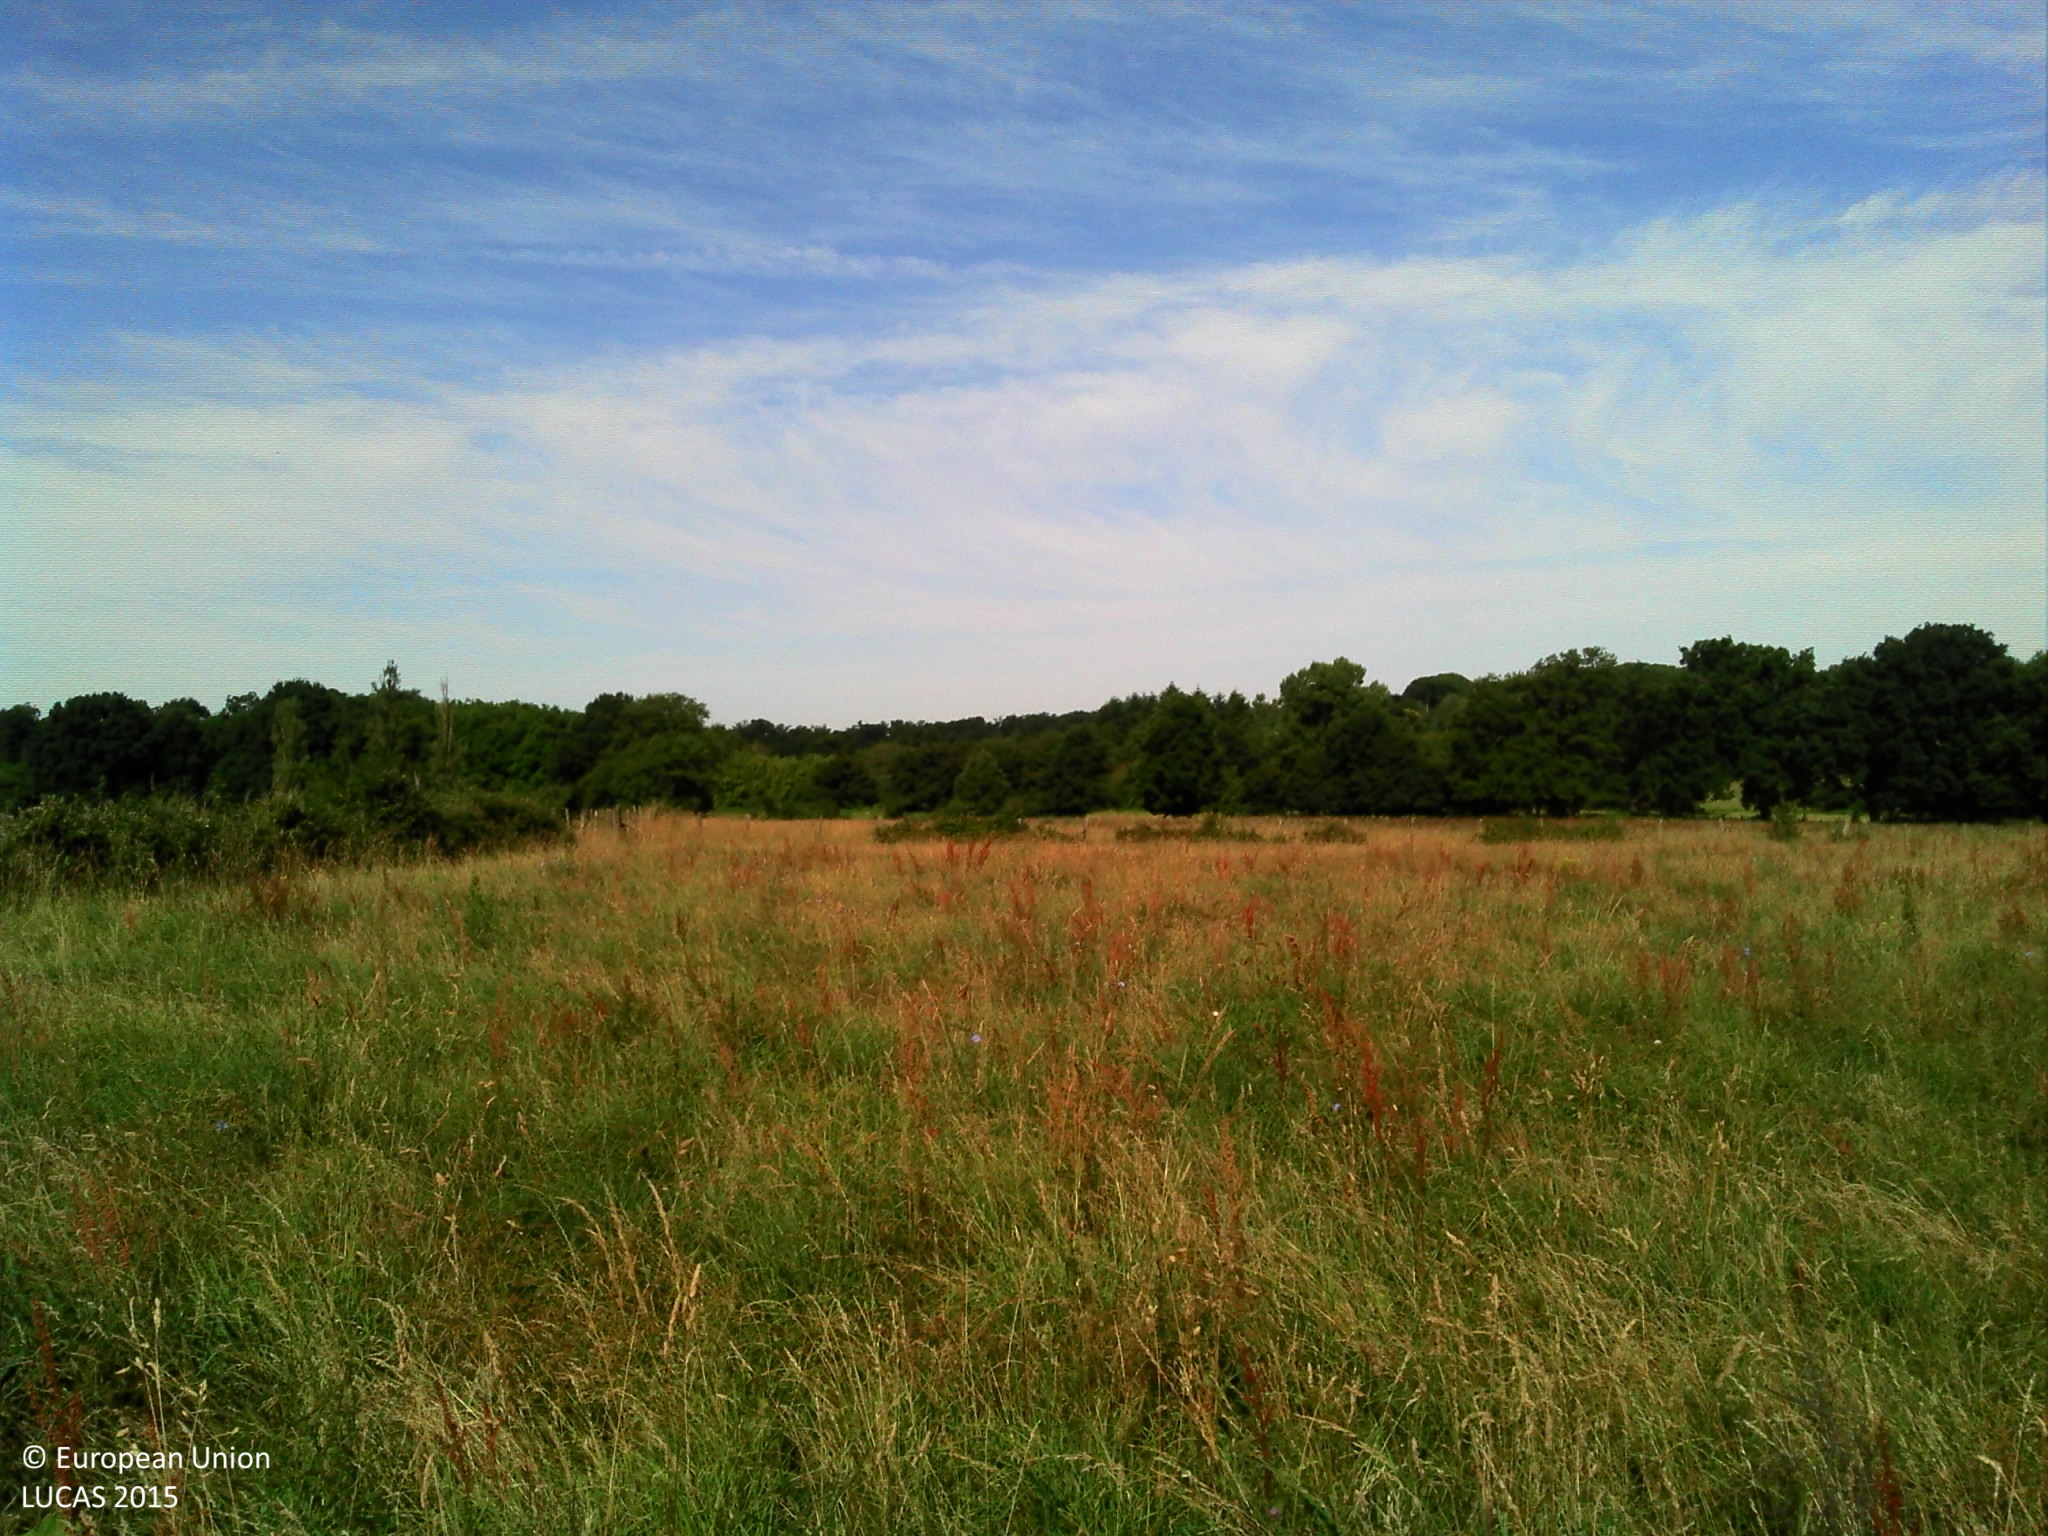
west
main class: Grassland
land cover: Grassland without tree/shrub cover
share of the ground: > 75 %
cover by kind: herbaceous plants 100 %
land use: Agriculture (excluding fallow land and kitchen gardens)
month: June
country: FR
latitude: 45.7404
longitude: 0.4360
